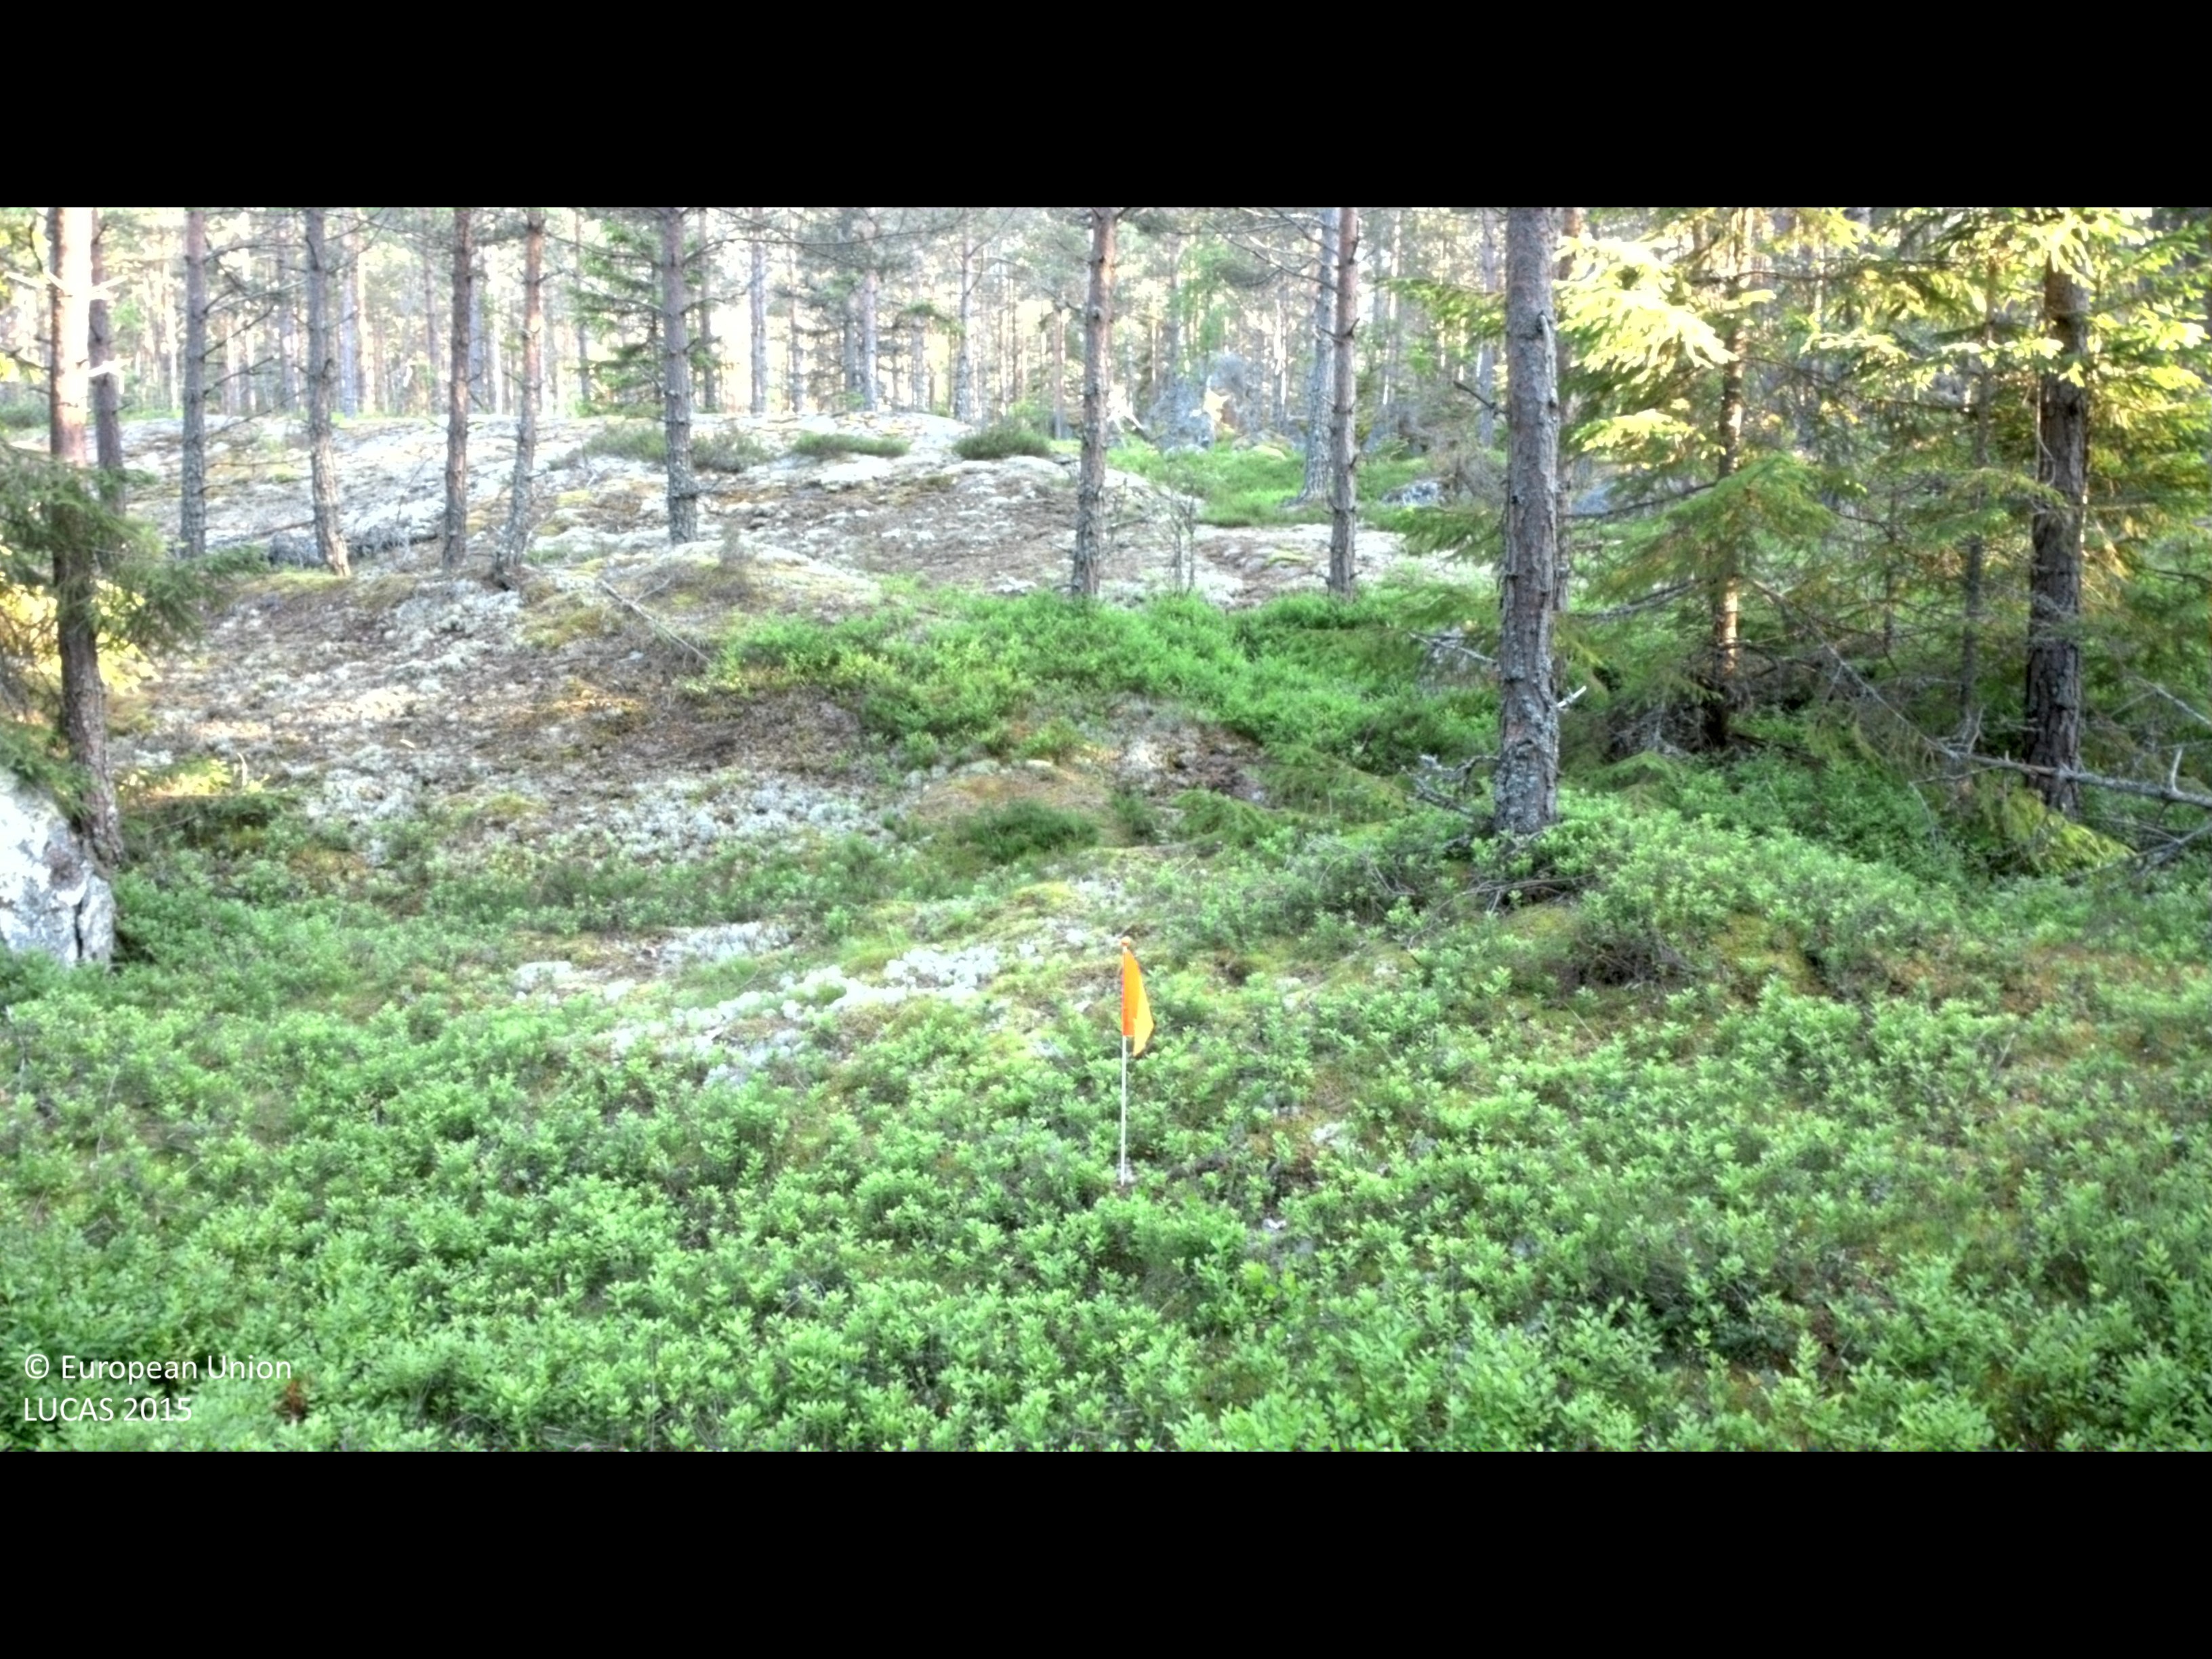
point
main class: Woodland
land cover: Pine dominated coniferous woodland
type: boreal forest
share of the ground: 50 - 75 %
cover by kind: coniferous forest trees 55 %, shrubs 30 %, lichens and mosses 15 %
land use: Forestry
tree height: > 5 m
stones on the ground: < 10 %
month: June
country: SE
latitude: 57.9829
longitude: 16.2712
